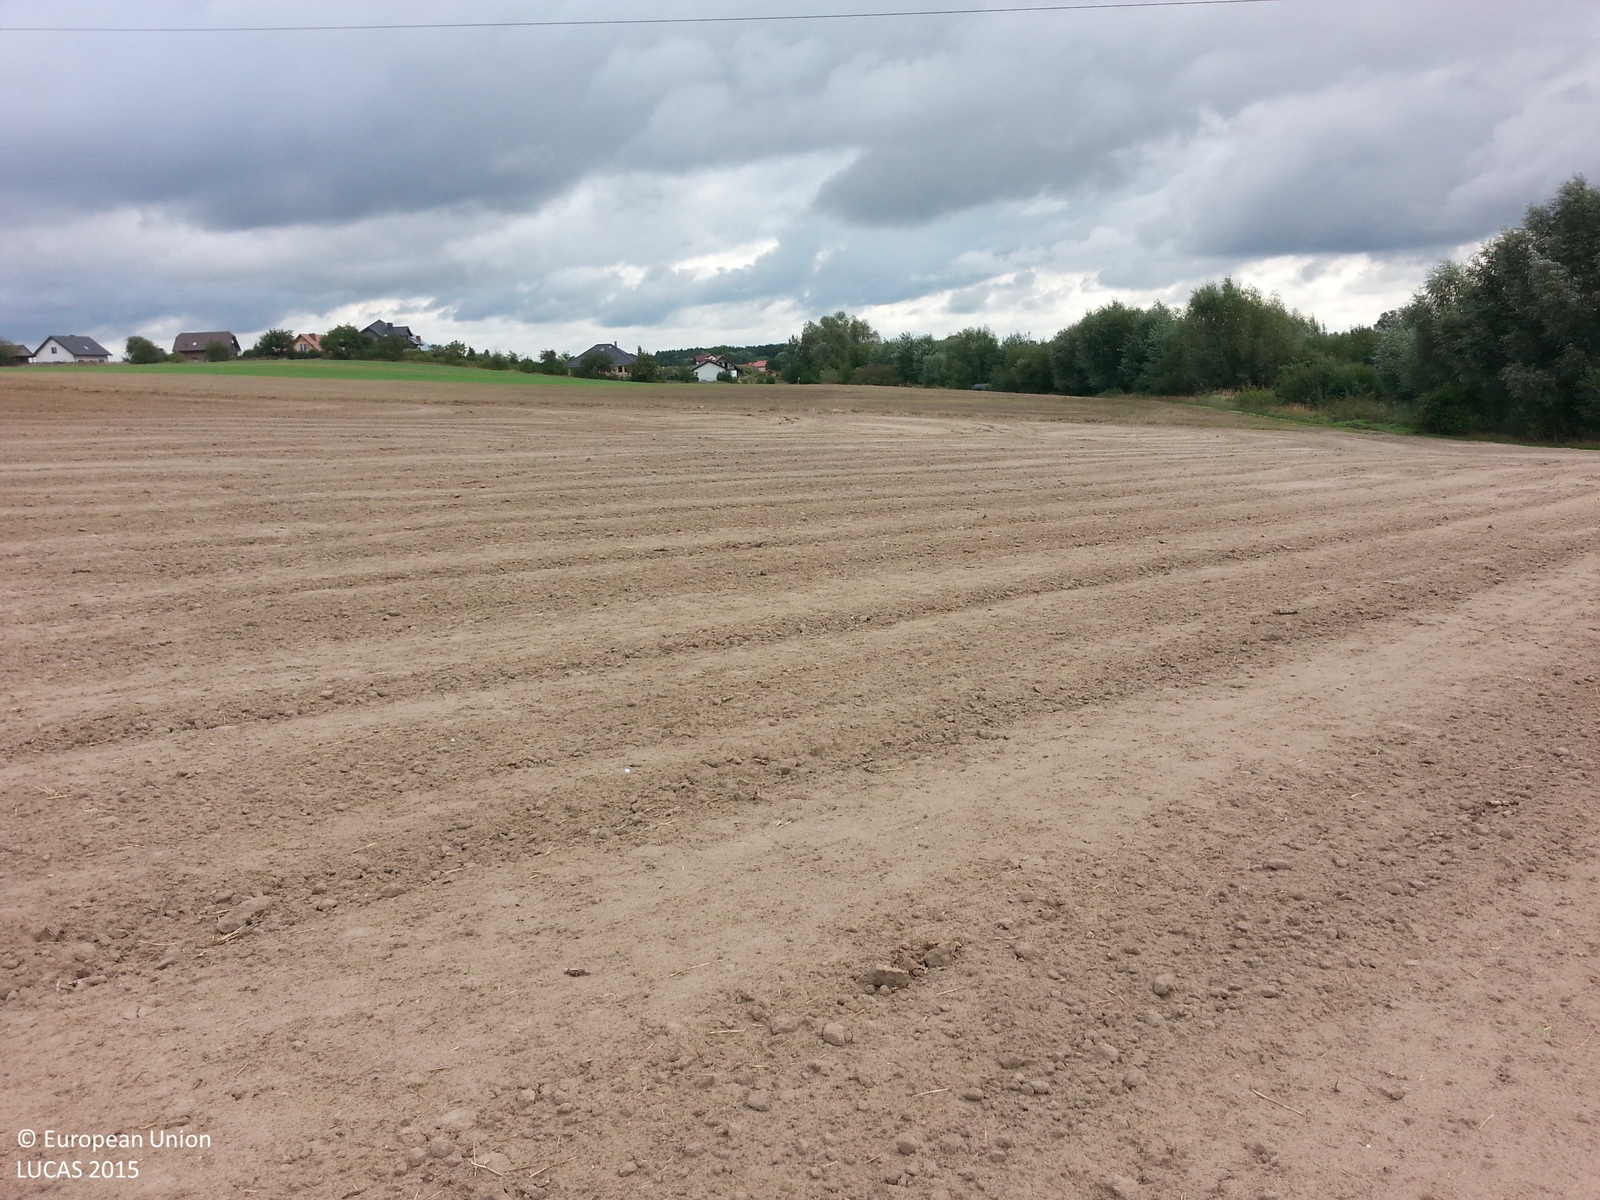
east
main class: Cropland
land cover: Common wheat
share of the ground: < 10 %
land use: Agriculture (excluding fallow land and kitchen gardens)
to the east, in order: Common wheat; Electric lines; Common wheat; Grass margins; Common wheat; Grass margins; Tracks; Grass margins; Broadleaved woodland
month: September
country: PL
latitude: 53.2531
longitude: 18.1548
